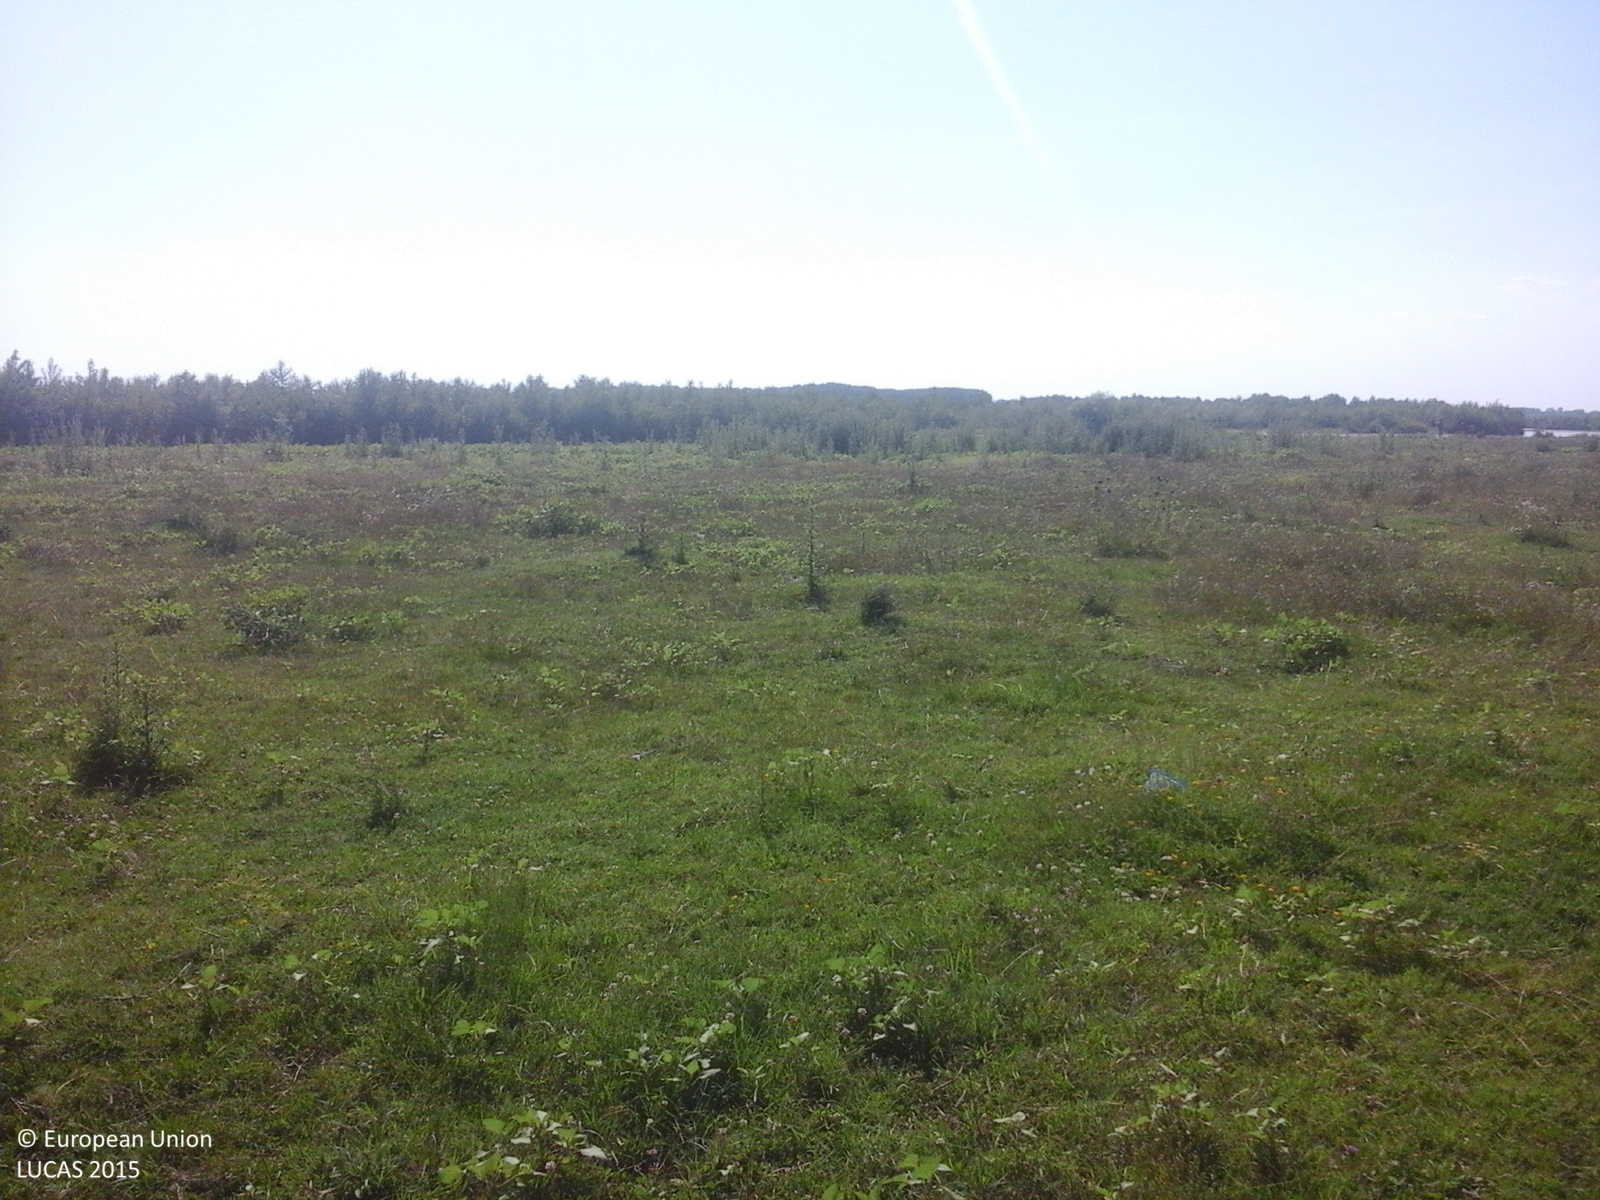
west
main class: Grassland
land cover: Grassland without tree/shrub cover
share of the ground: > 75 %
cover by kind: herbaceous plants 100 %
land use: Agriculture (excluding fallow land and kitchen gardens)
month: July
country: RO
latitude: 44.2500
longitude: 24.3044
